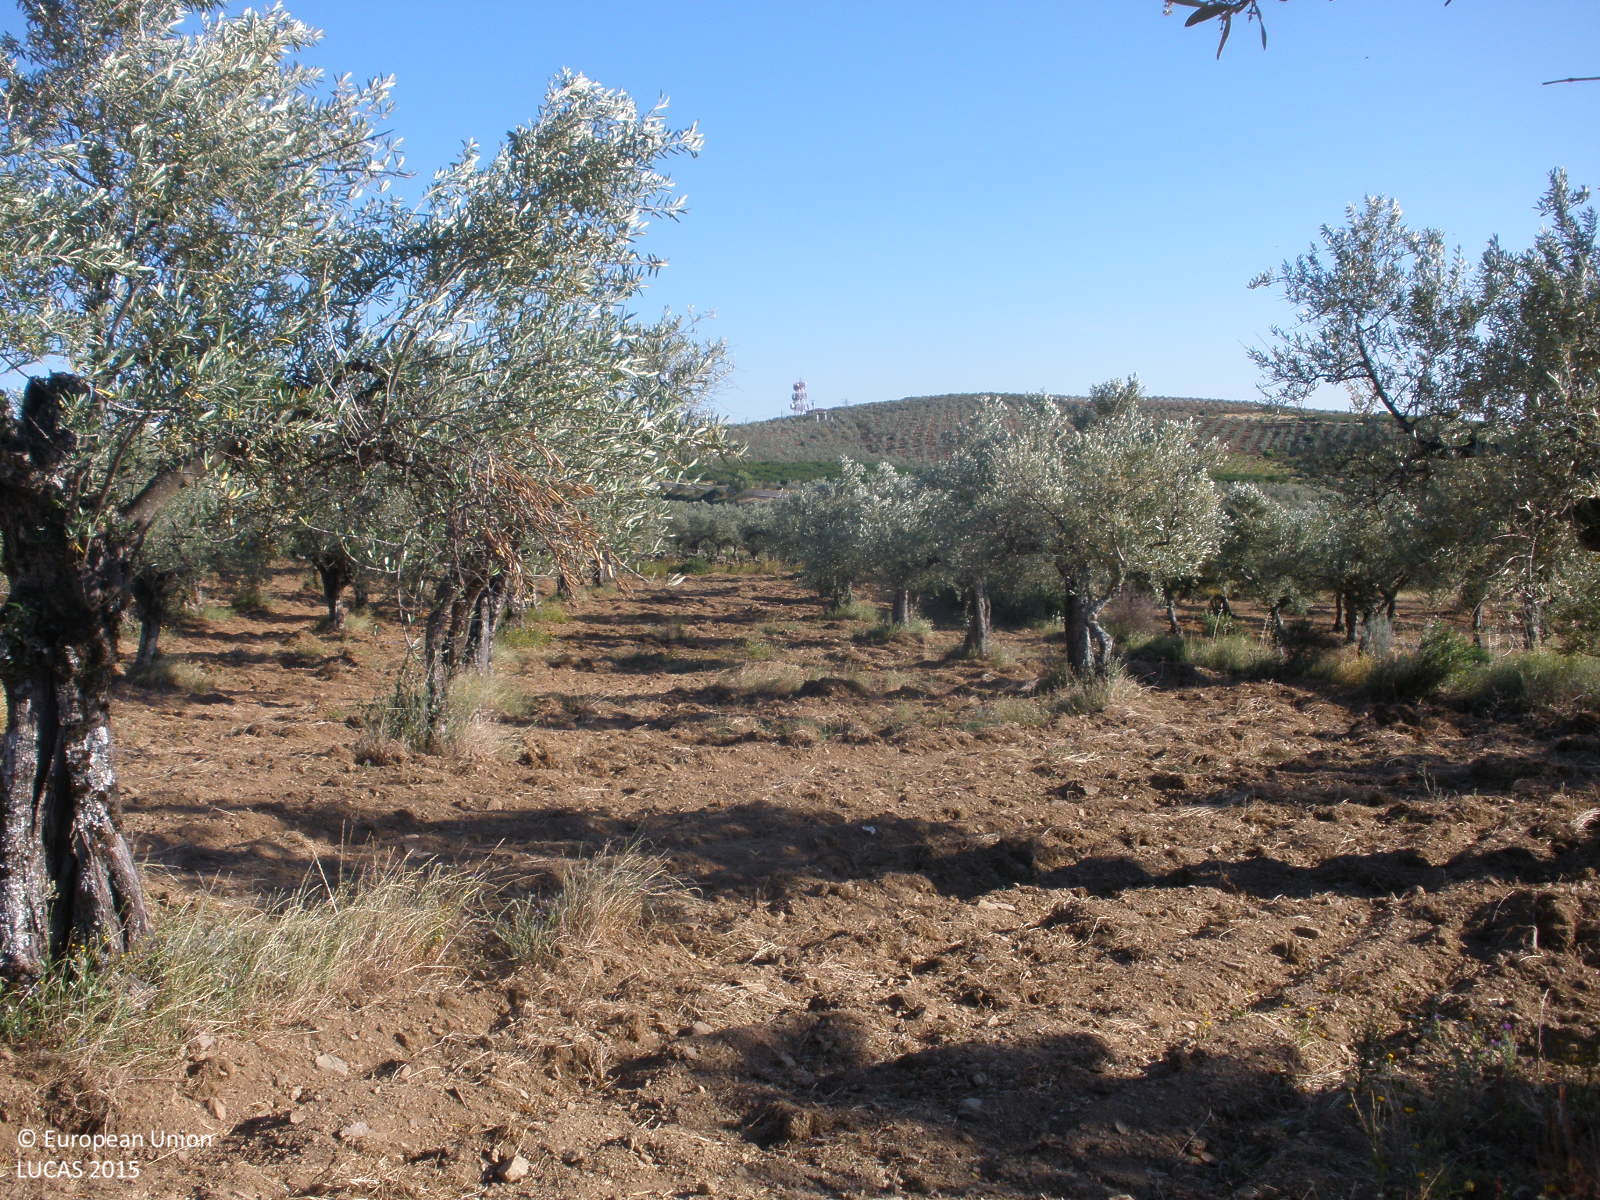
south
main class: Cropland
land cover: Olive groves
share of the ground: 50 - 75 %
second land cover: Spontaneously vegetated surfaces
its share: > 75 %
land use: Agriculture (excluding fallow land and kitchen gardens)
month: May
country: ES
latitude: 40.2552
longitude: -6.1963
